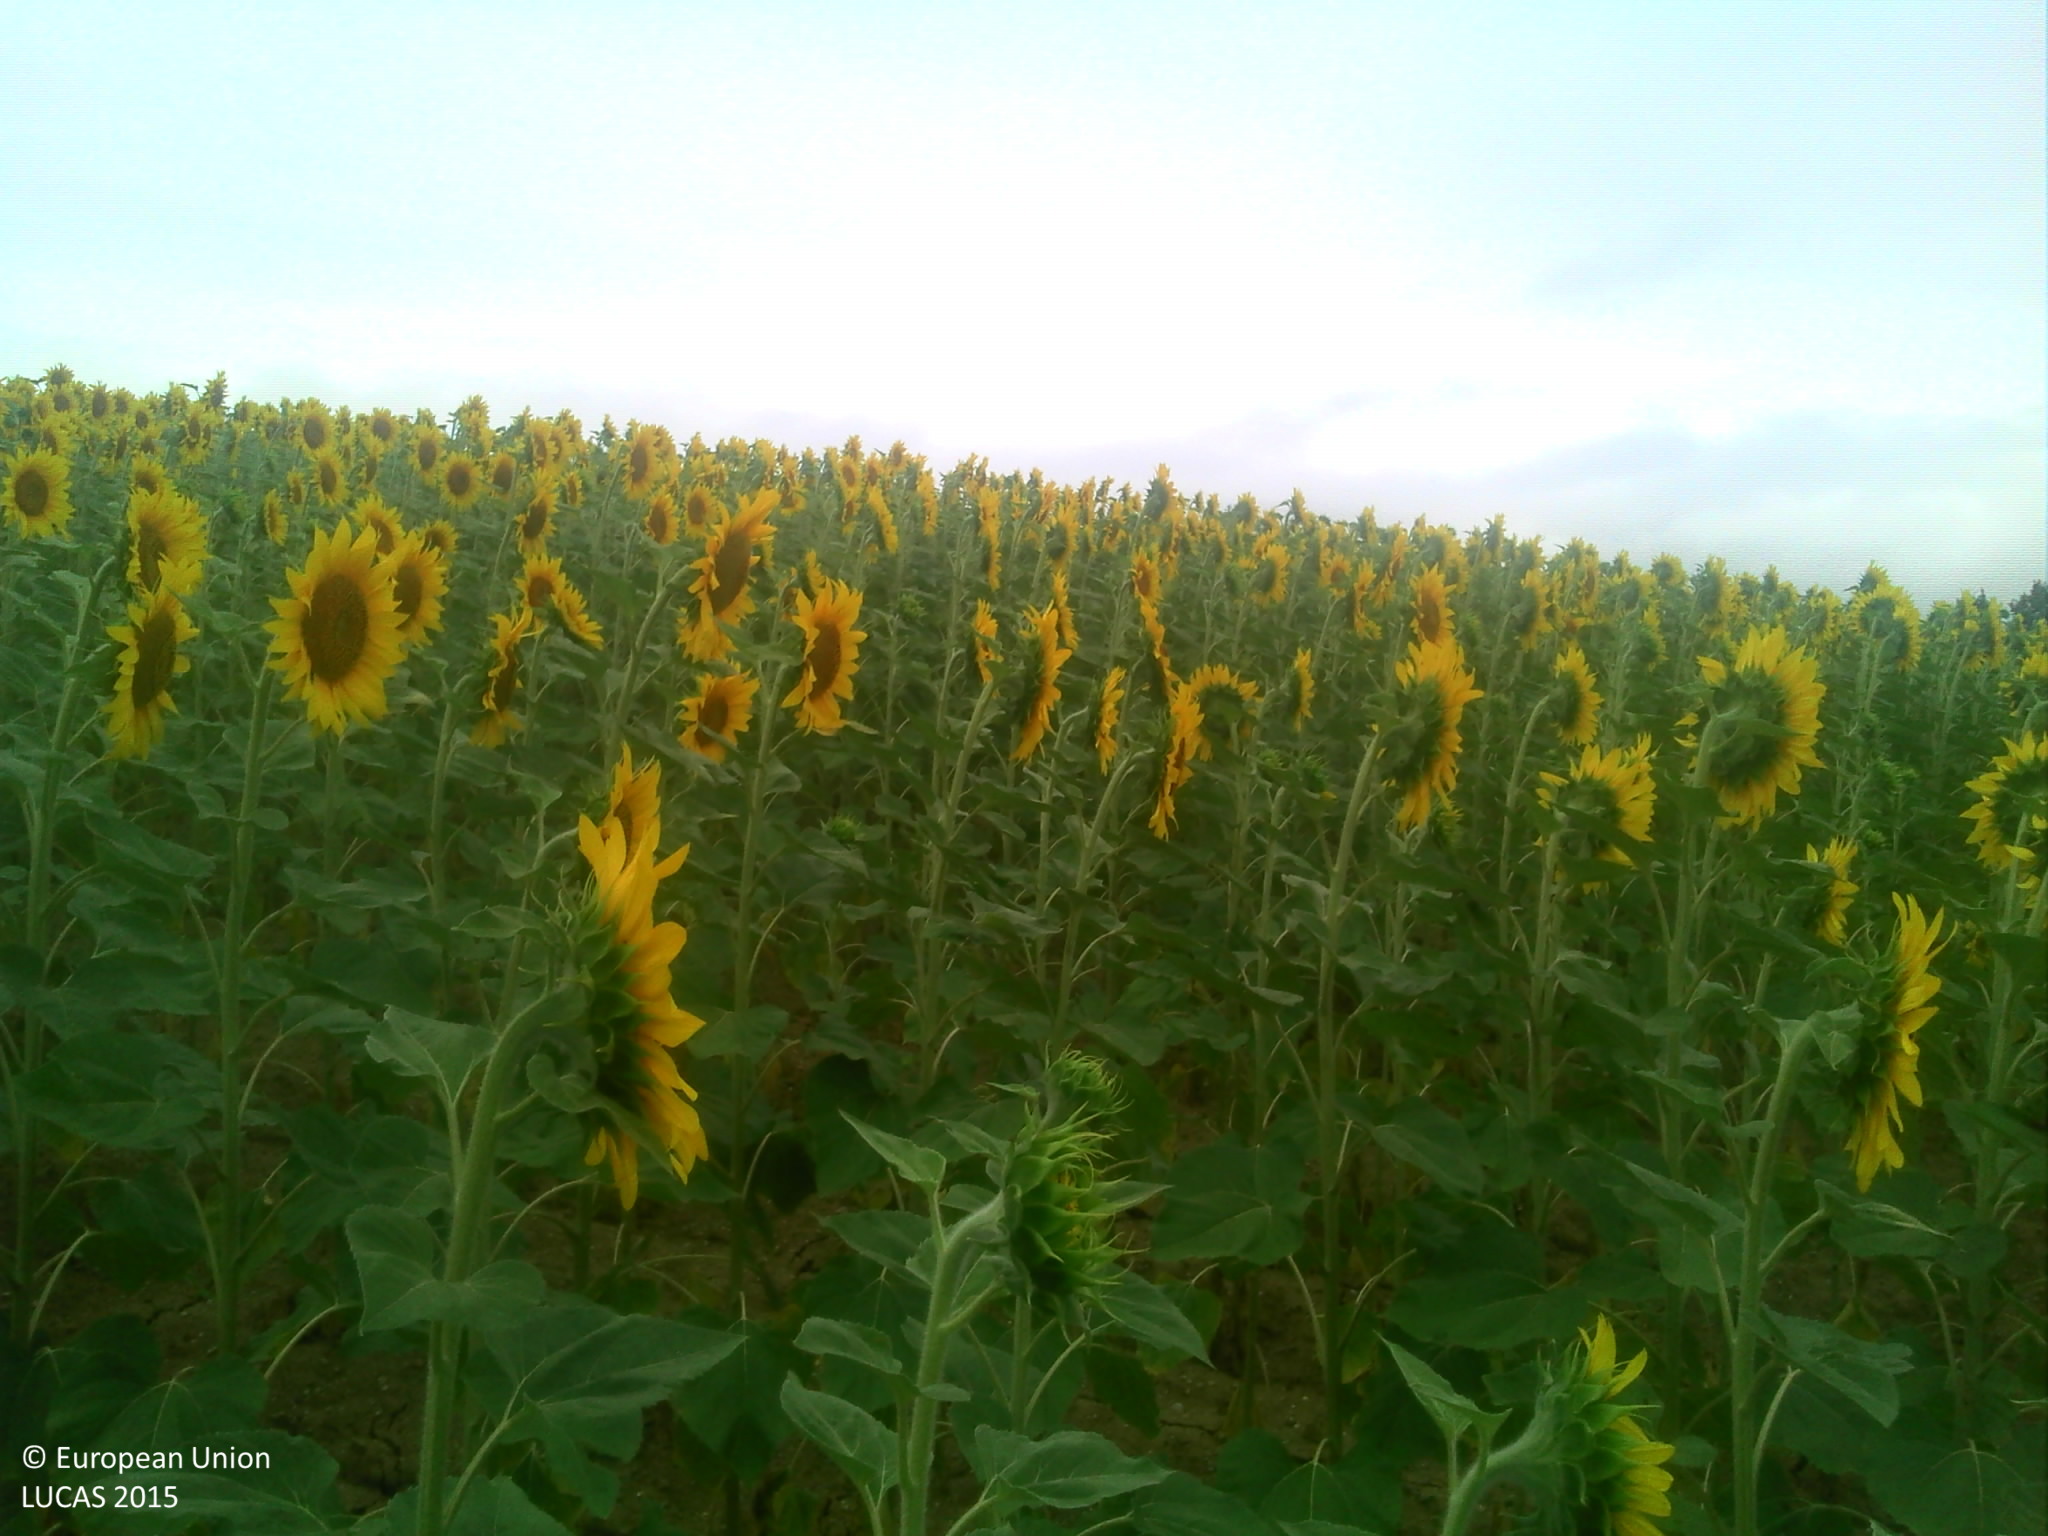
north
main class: Cropland
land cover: Sunflower
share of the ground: > 75 %
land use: Agriculture (excluding fallow land and kitchen gardens)
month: July
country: FR
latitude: 43.2194
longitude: 1.4736
